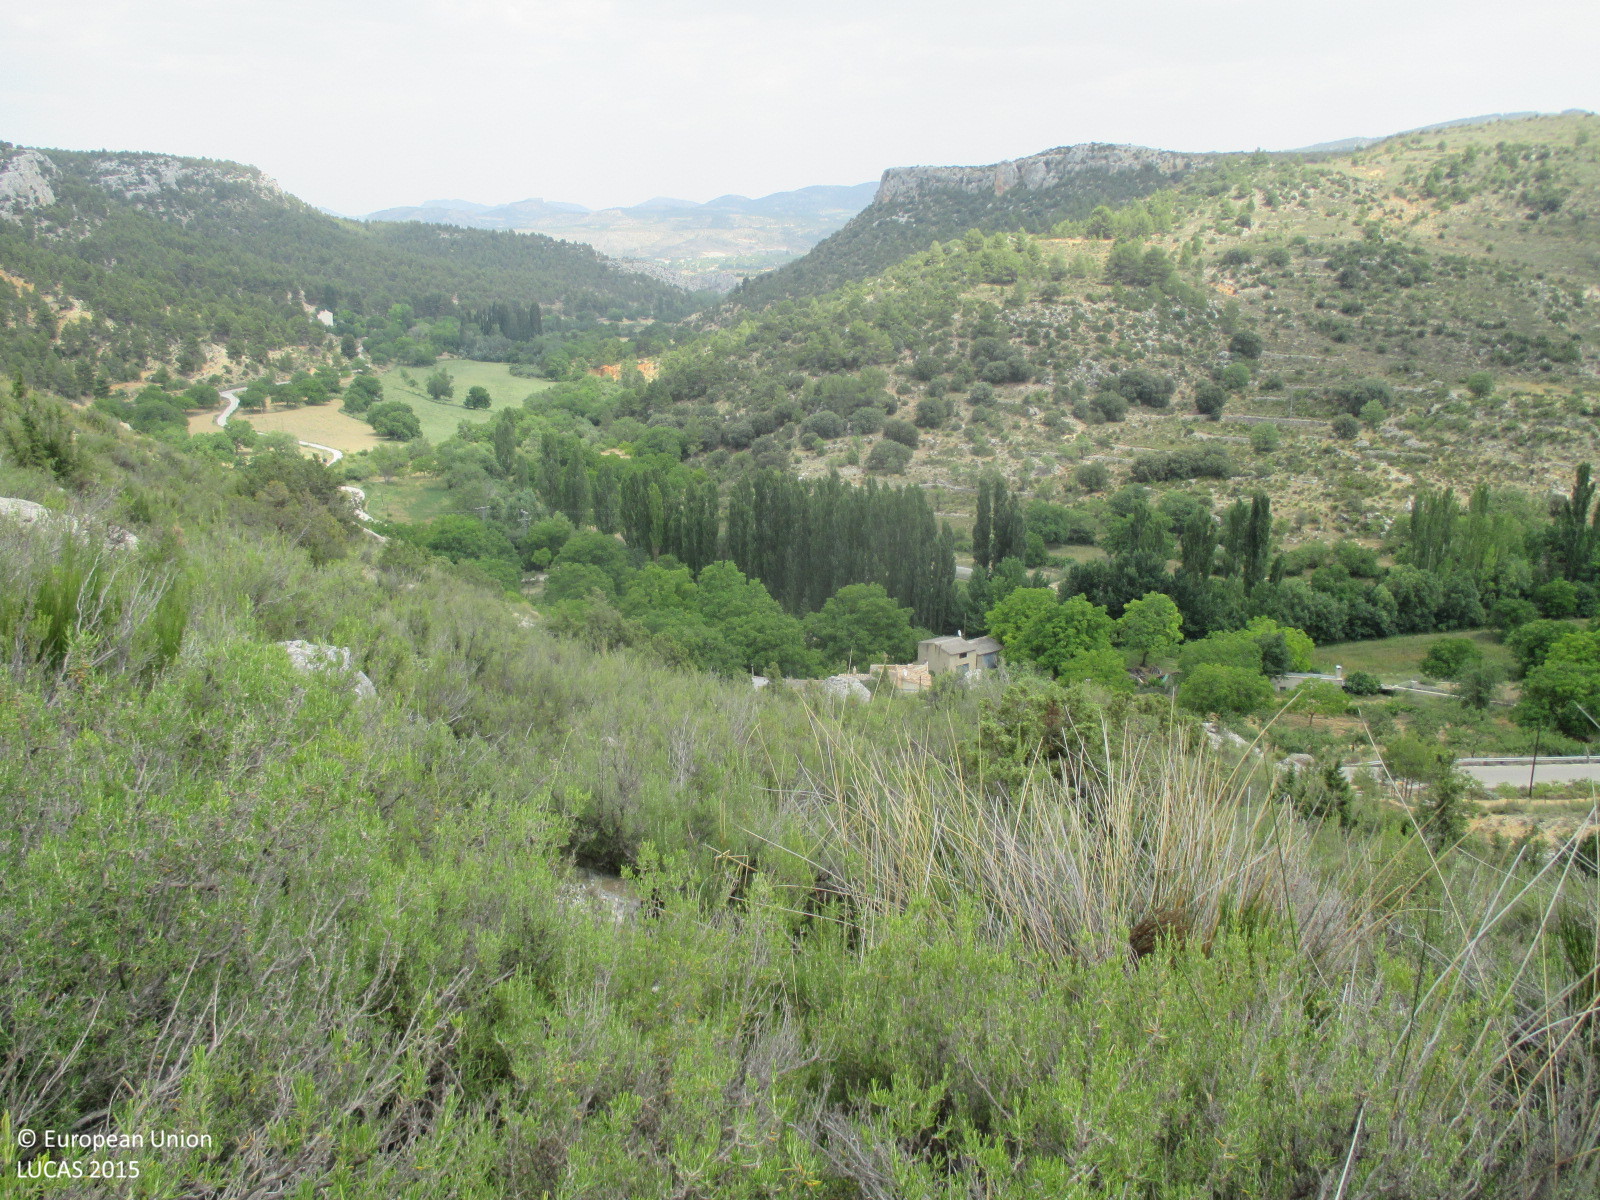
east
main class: Shrubland
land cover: Shrubland with sparse tree cover
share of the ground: > 75 %
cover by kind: shrubs 95 %, broadleaved forest trees 5 %
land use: Semi-natural and natural areas not in use
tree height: > 5 m
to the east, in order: Shrubland with sparse tree cover; Grassland without tree/shrub cover; Paved roads, cycling and walking lanes; Grass margins; Artificial constructions in urban areas; Spontaneously vegetated surfaces; Shruby margins; Nuts trees
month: July
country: ES
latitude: 38.1480
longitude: -2.3512
